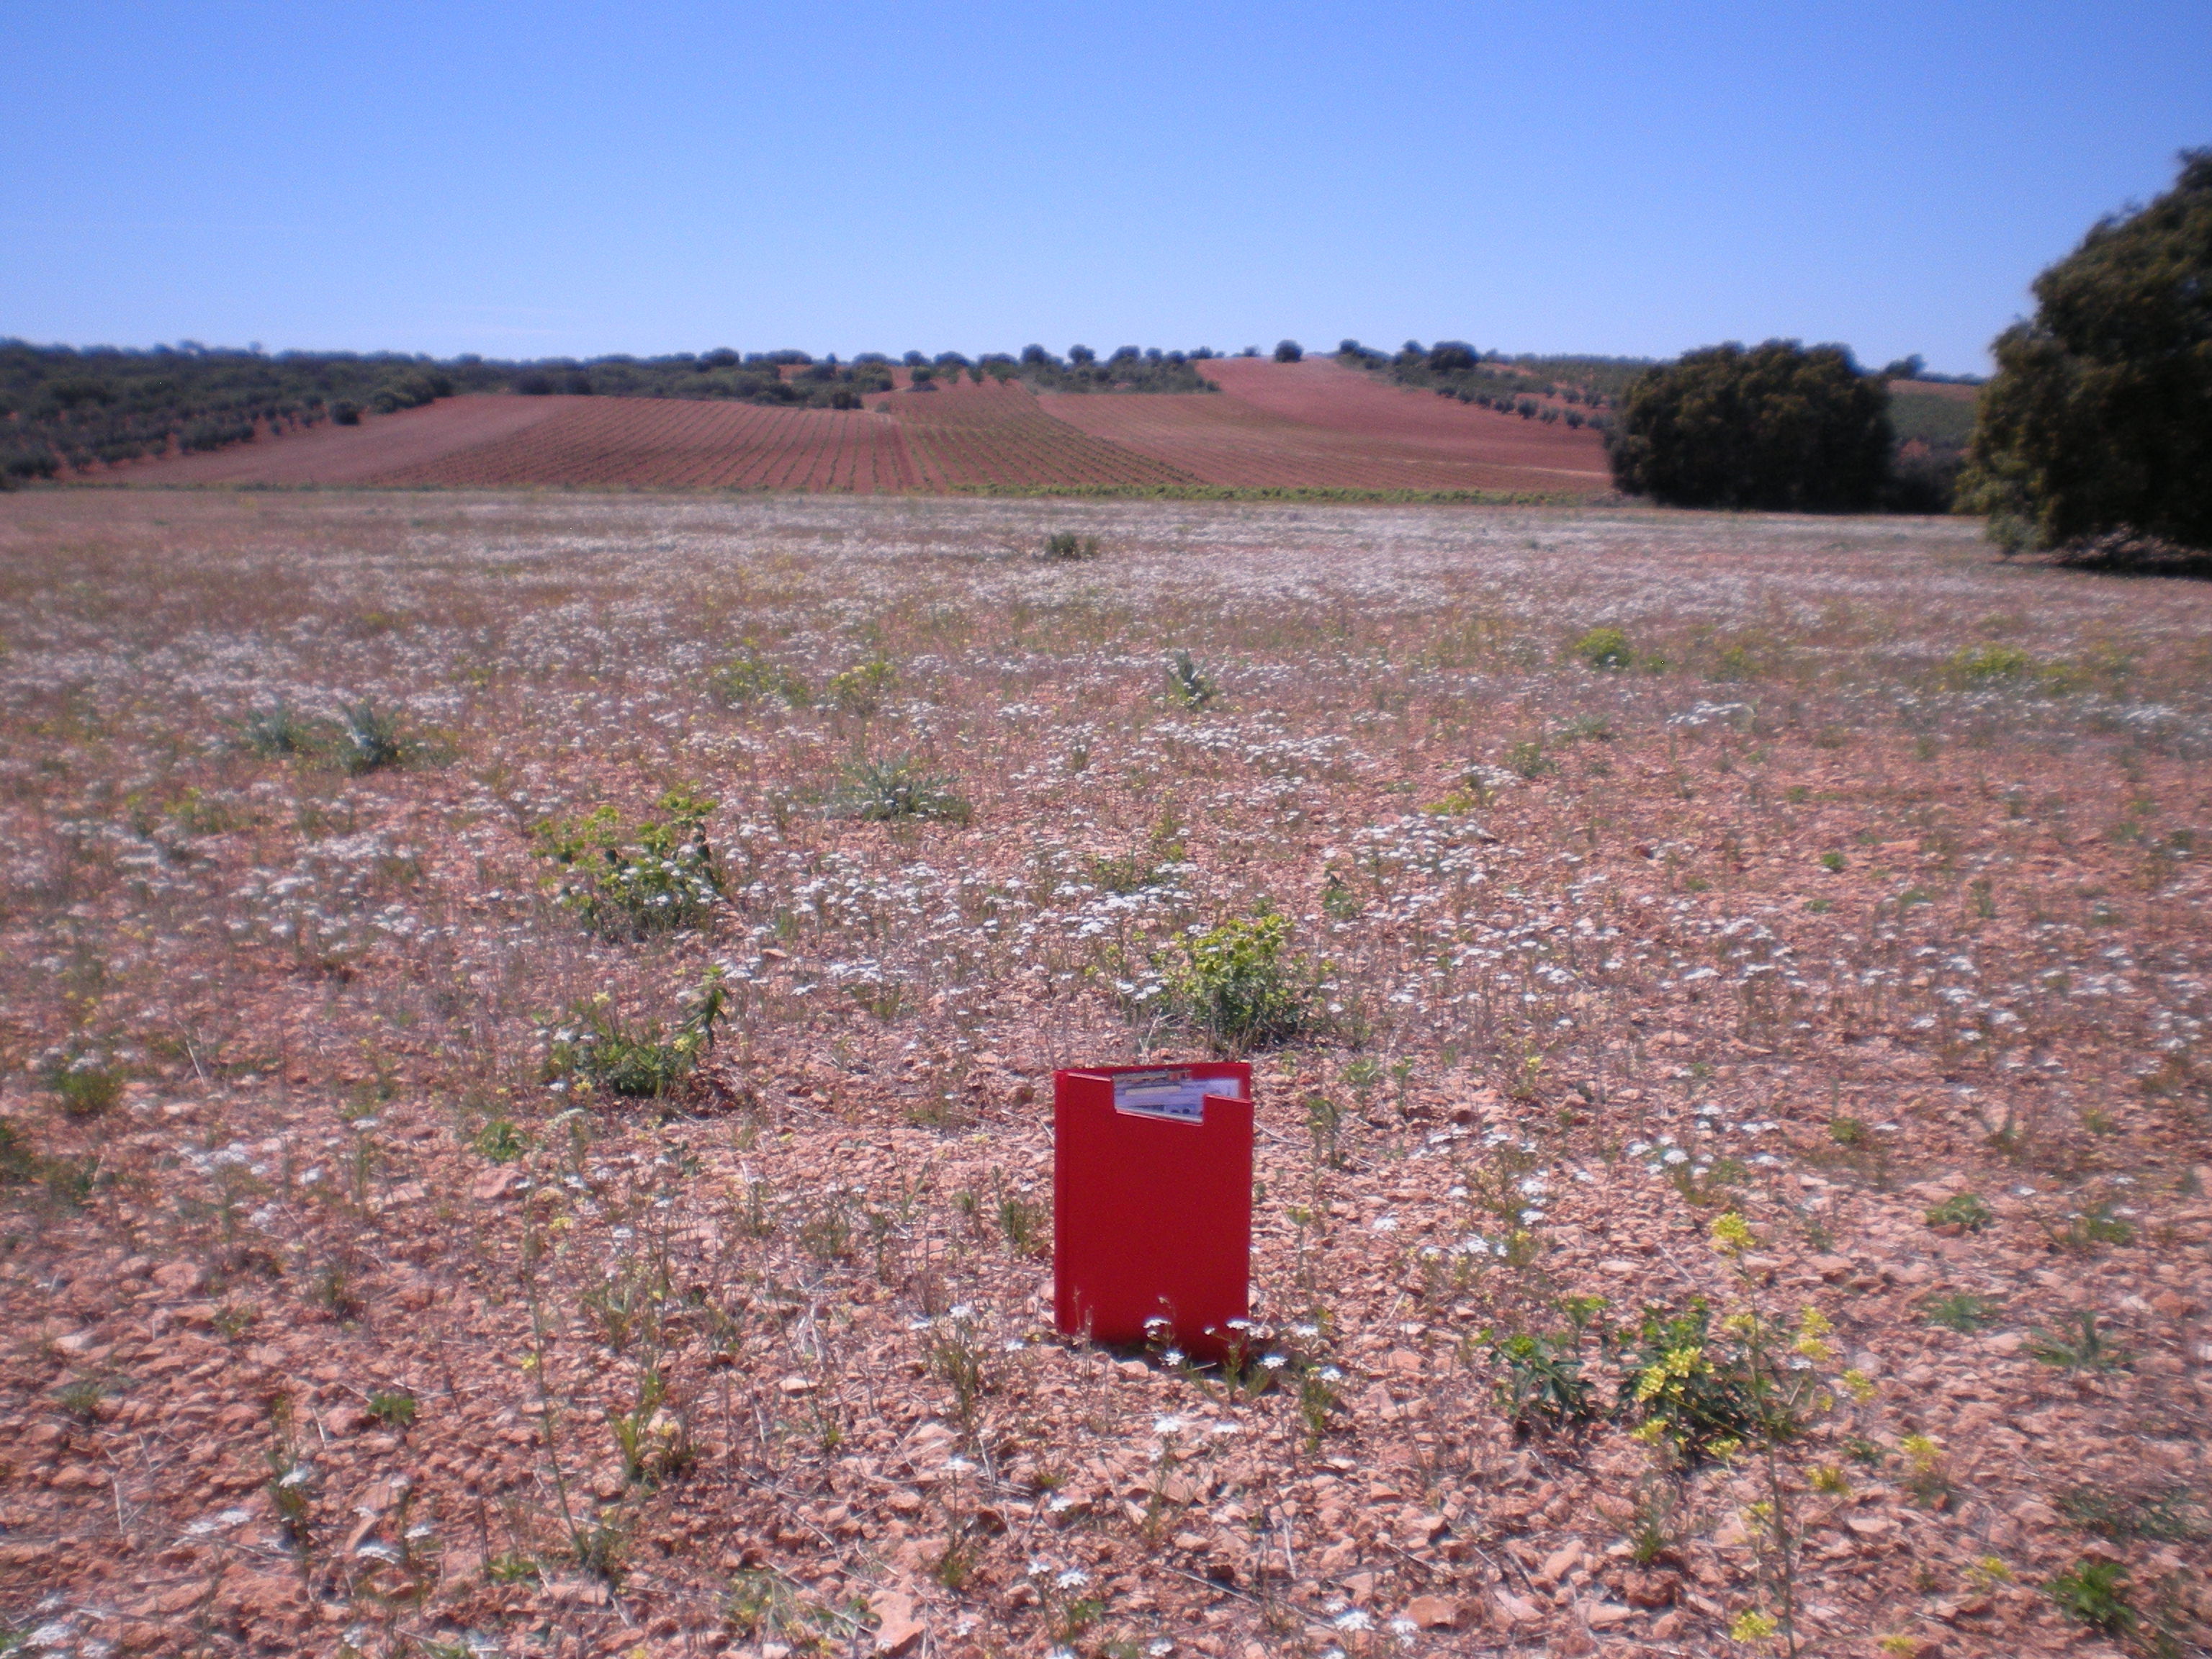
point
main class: Grassland
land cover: Spontaneously vegetated surfaces
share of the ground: > 75 %
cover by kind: unconsolidated bare surface 70 %, herbaceous plants 30 %
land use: Fallow land
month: May
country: ES
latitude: 38.9957
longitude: -2.9995
